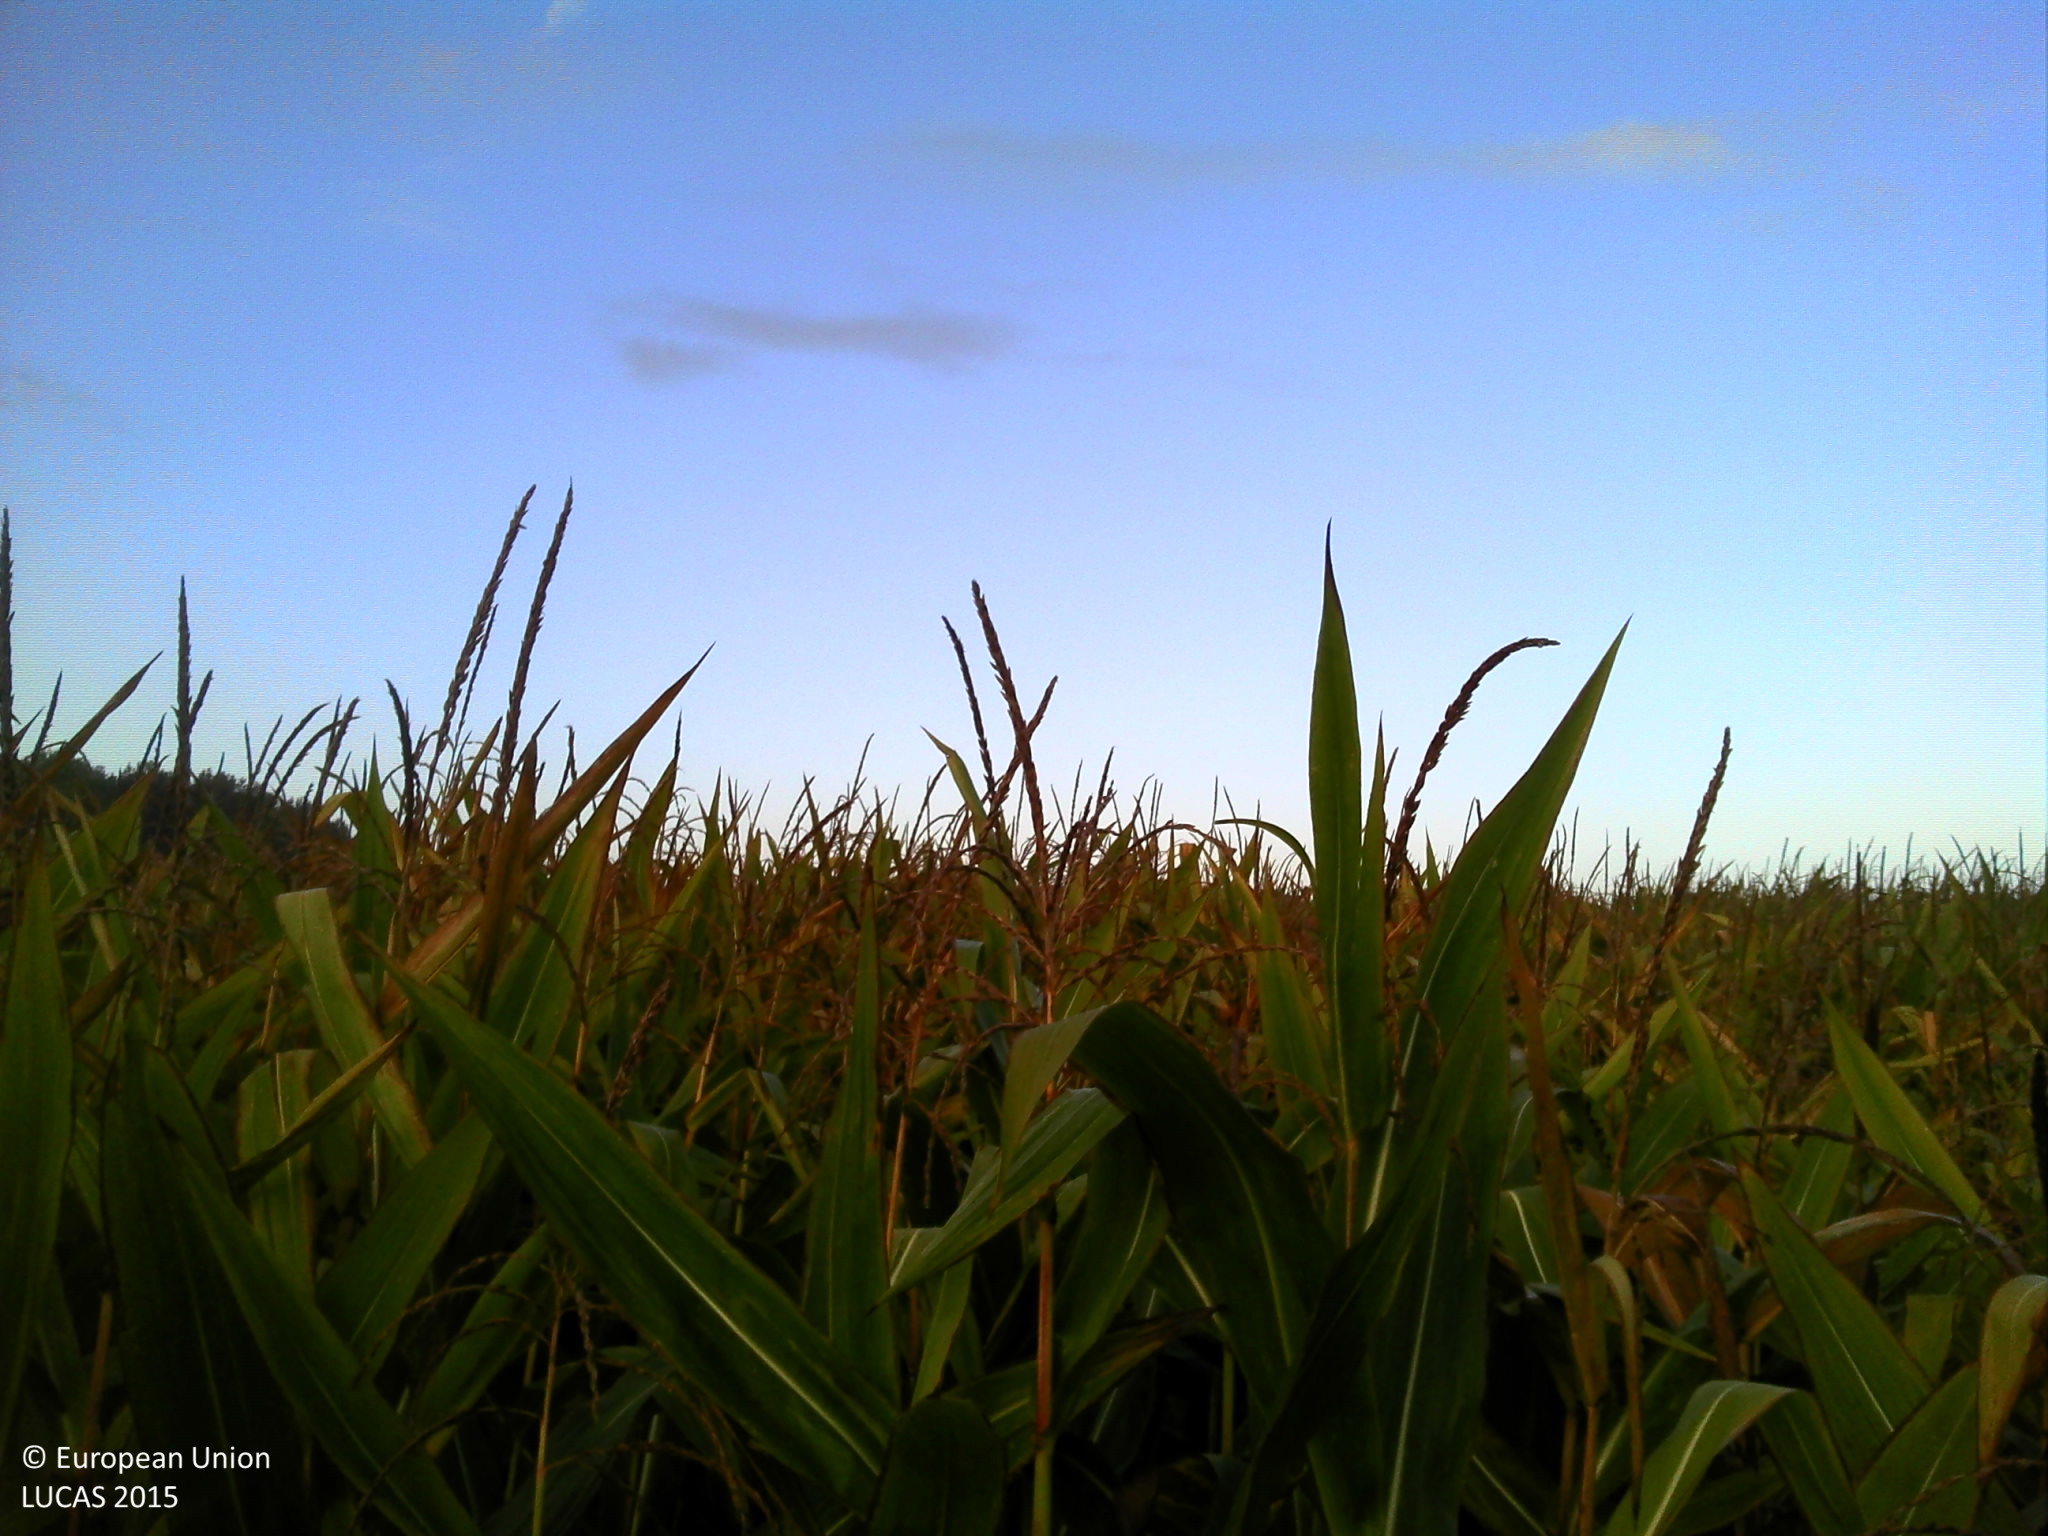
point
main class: Cropland
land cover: Maize
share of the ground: > 75 %
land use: Agriculture (excluding fallow land and kitchen gardens)
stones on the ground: < 10 %
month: September
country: BE
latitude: 51.0747
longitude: 4.4149
